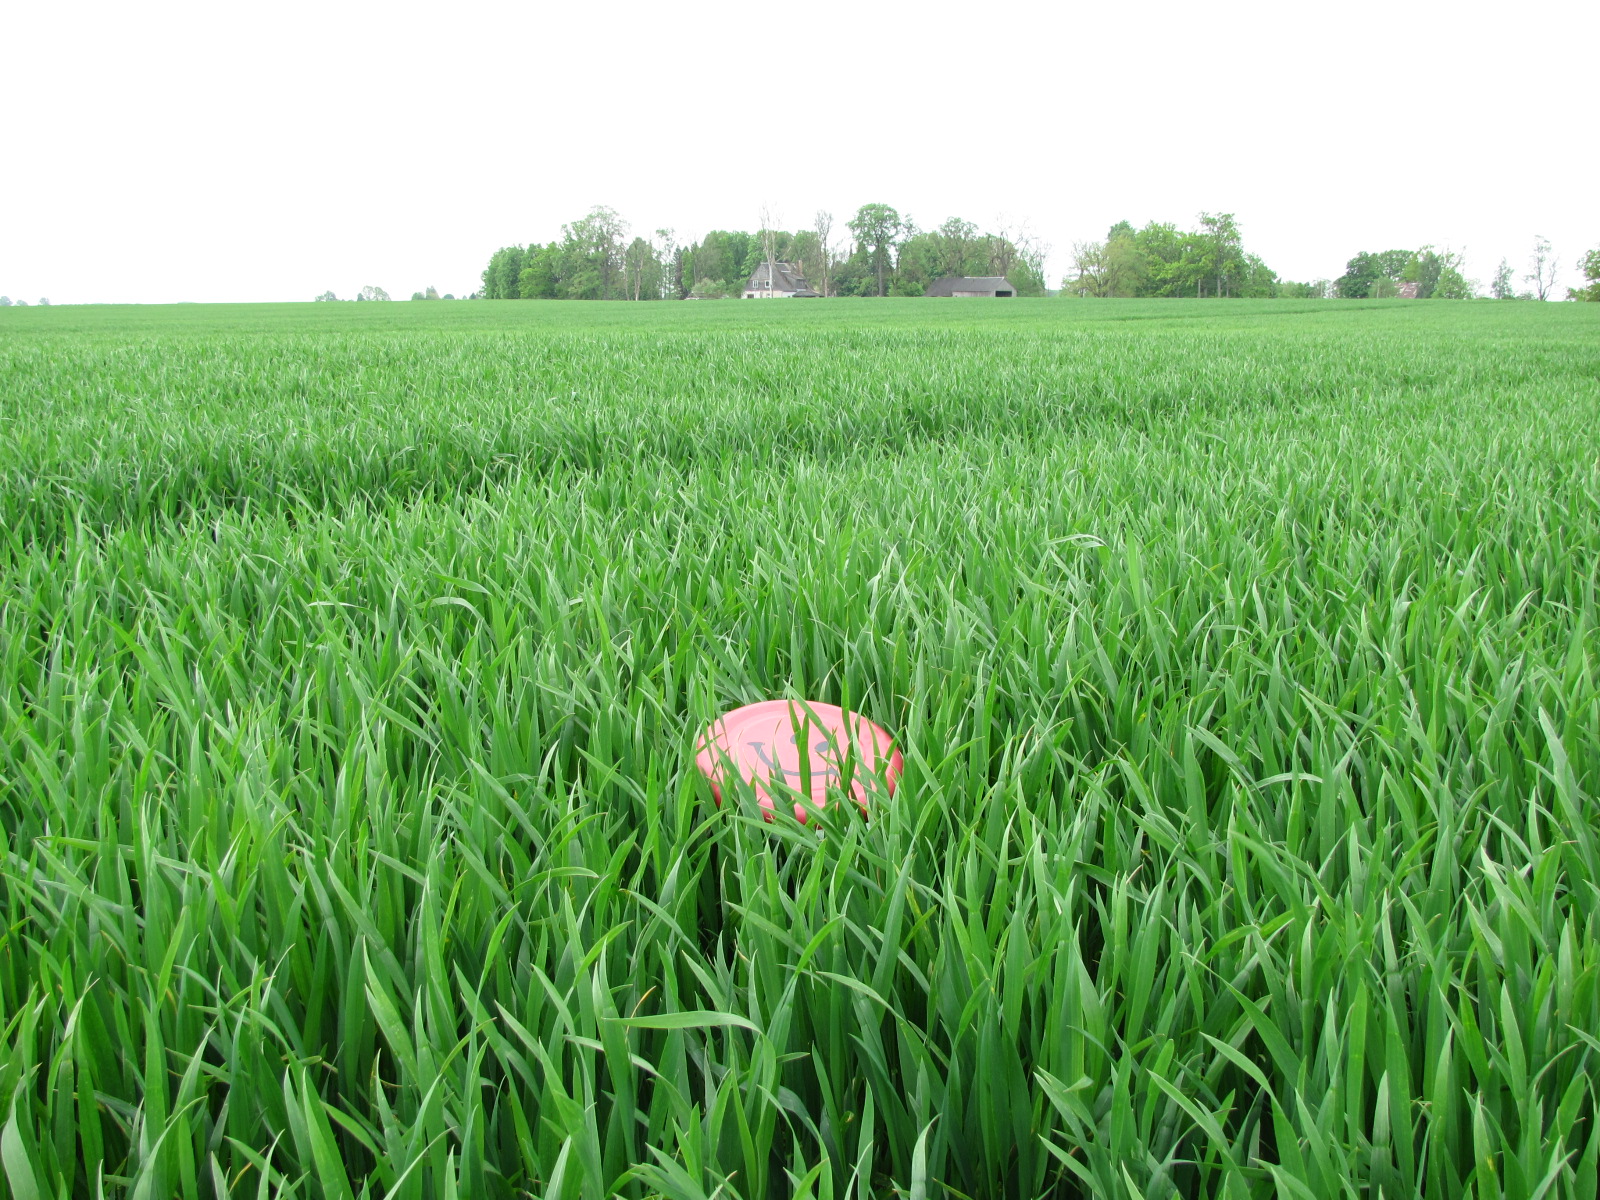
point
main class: Cropland
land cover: Common wheat
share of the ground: > 75 %
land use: Agriculture (excluding fallow land and kitchen gardens)
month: May
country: LV
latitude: 56.4651
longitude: 24.0941
